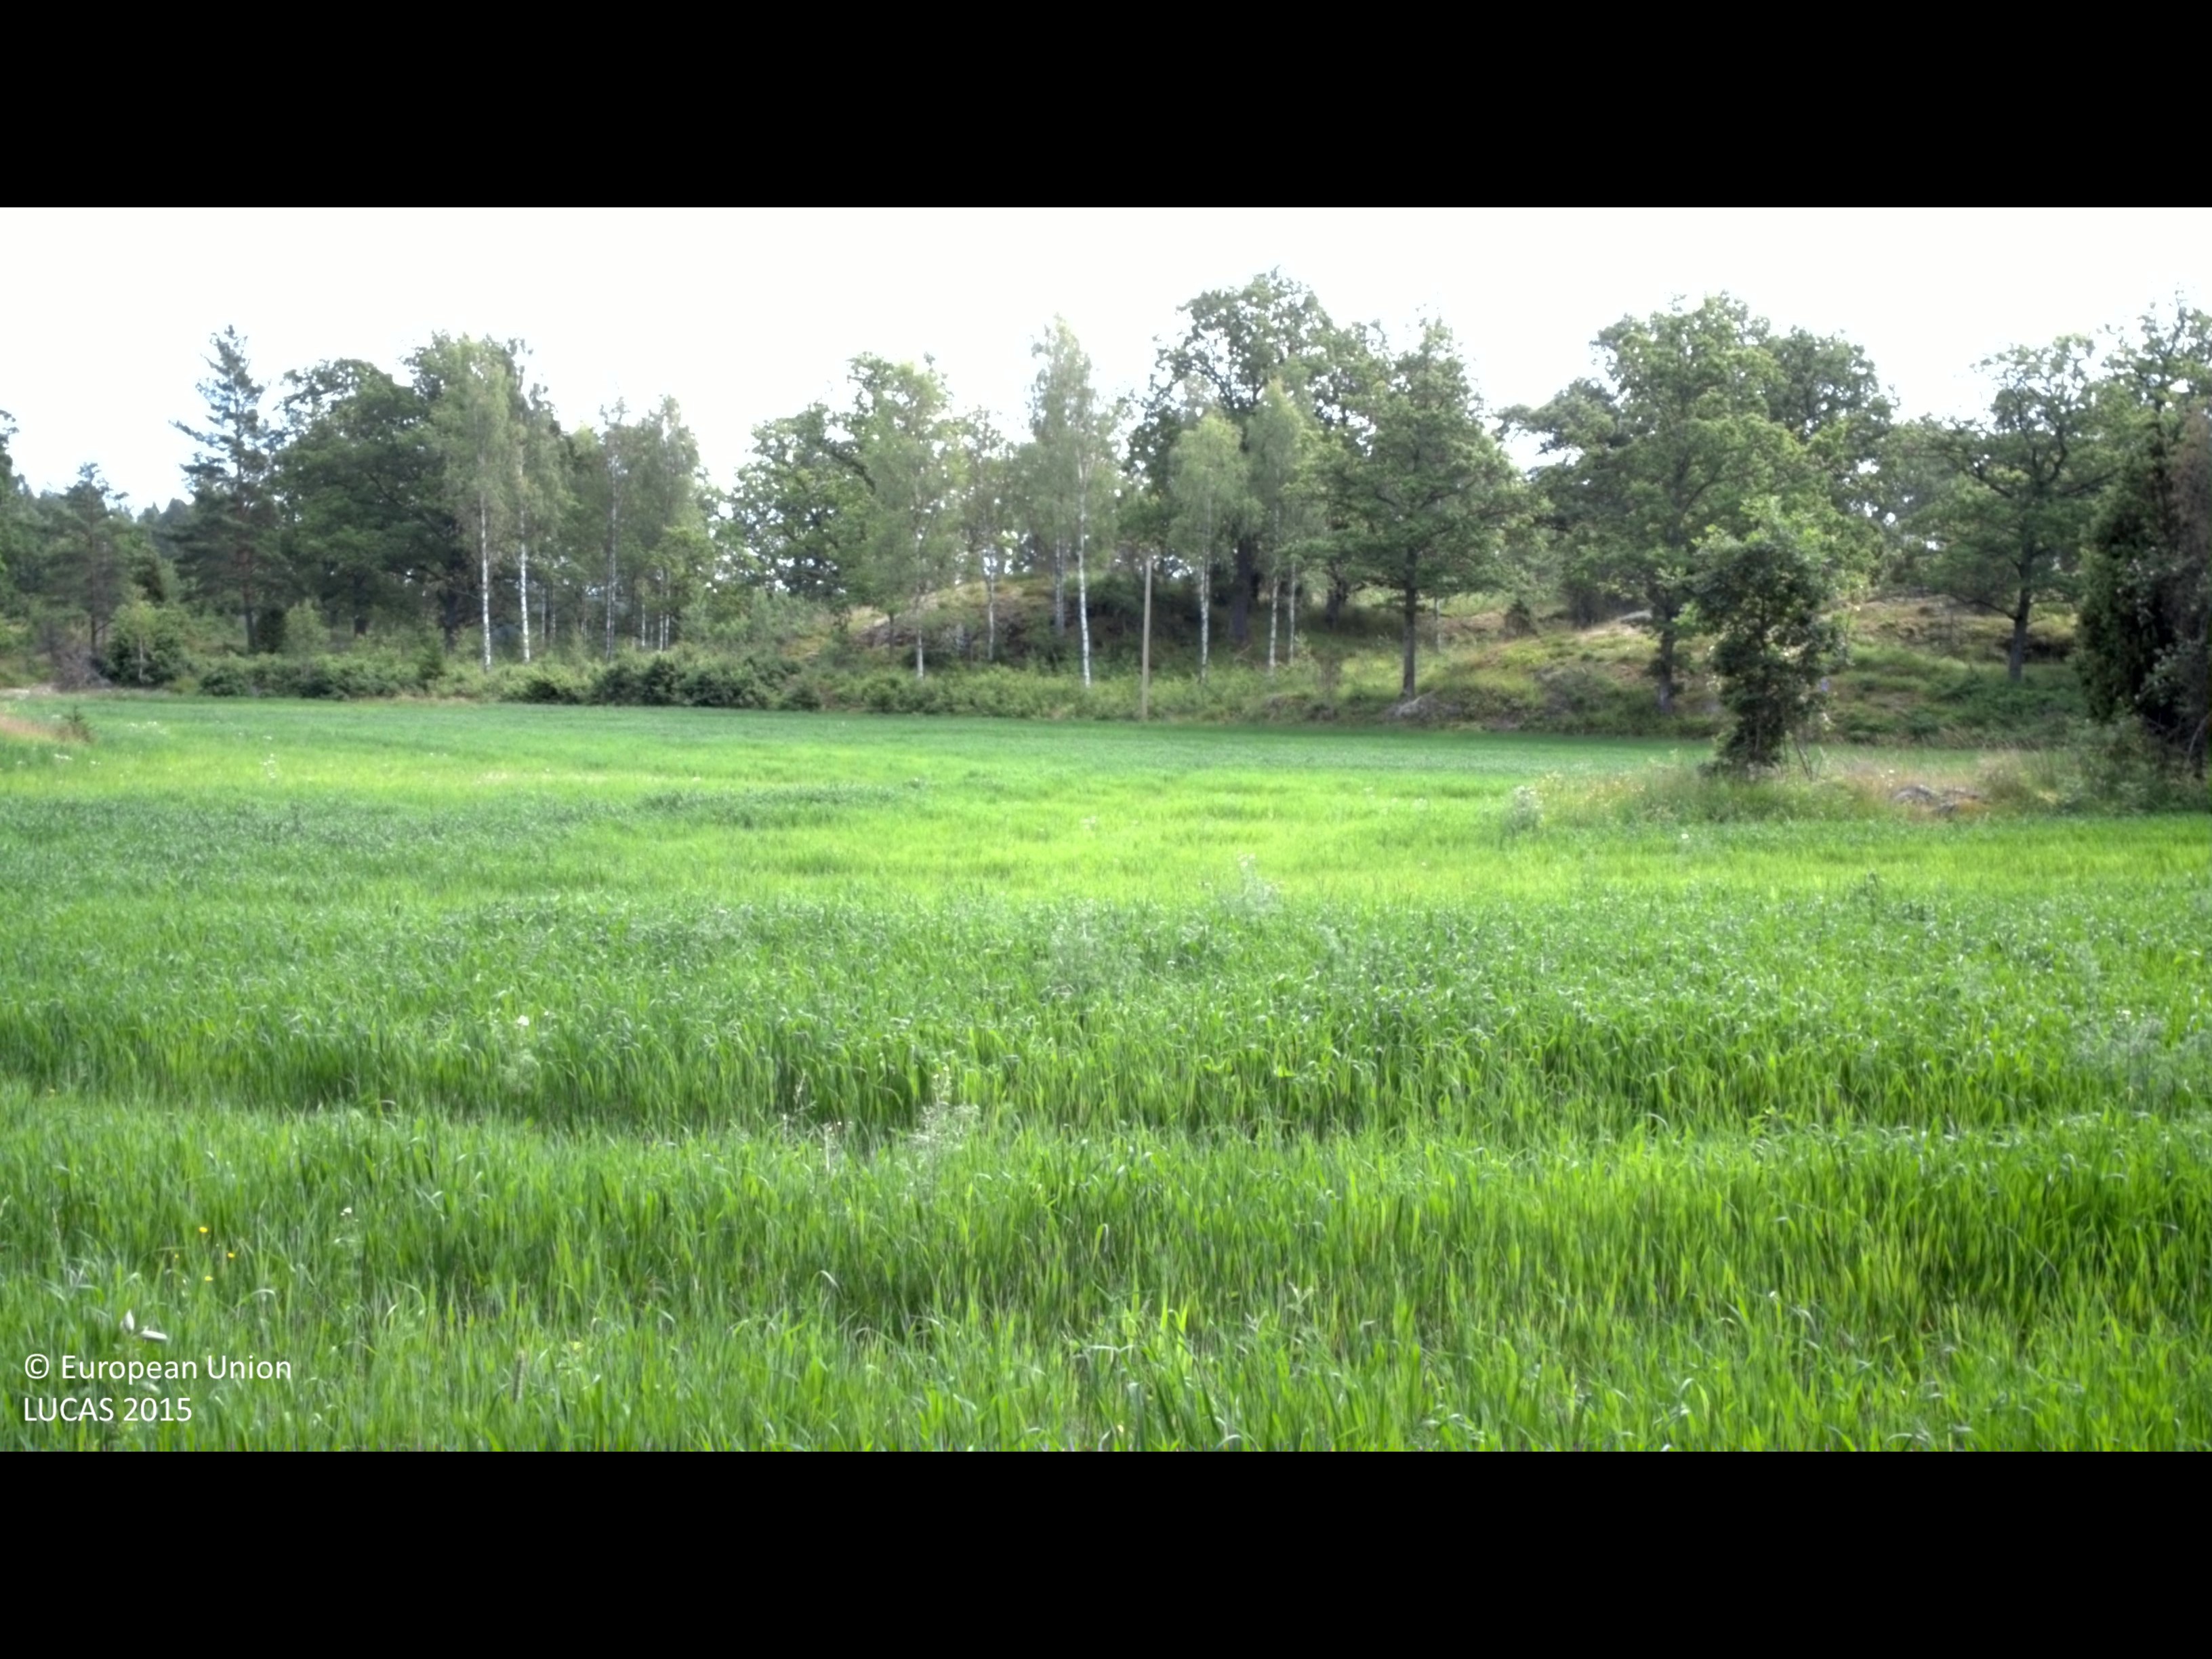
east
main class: Woodland
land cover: Other mixed woodland
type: boreal forest
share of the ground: > 75 %
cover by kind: coniferous forest trees 50 %, broadleaved forest trees 30 %, shrubs 15 %, herbaceous plants 5 %
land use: Forestry
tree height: > 5 m
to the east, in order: Other mixed woodland; Ditches and canals; Other leguminous and mixtures for fodder; Ditches and canals; Broadleaved woodland; Paved roads, cycling and walking lanes; Ditches and canals; Other leguminous and mixtures for fodder; Ditches and canals; Temporary grasslands
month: July
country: SE
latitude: 58.2905
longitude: 16.6326
